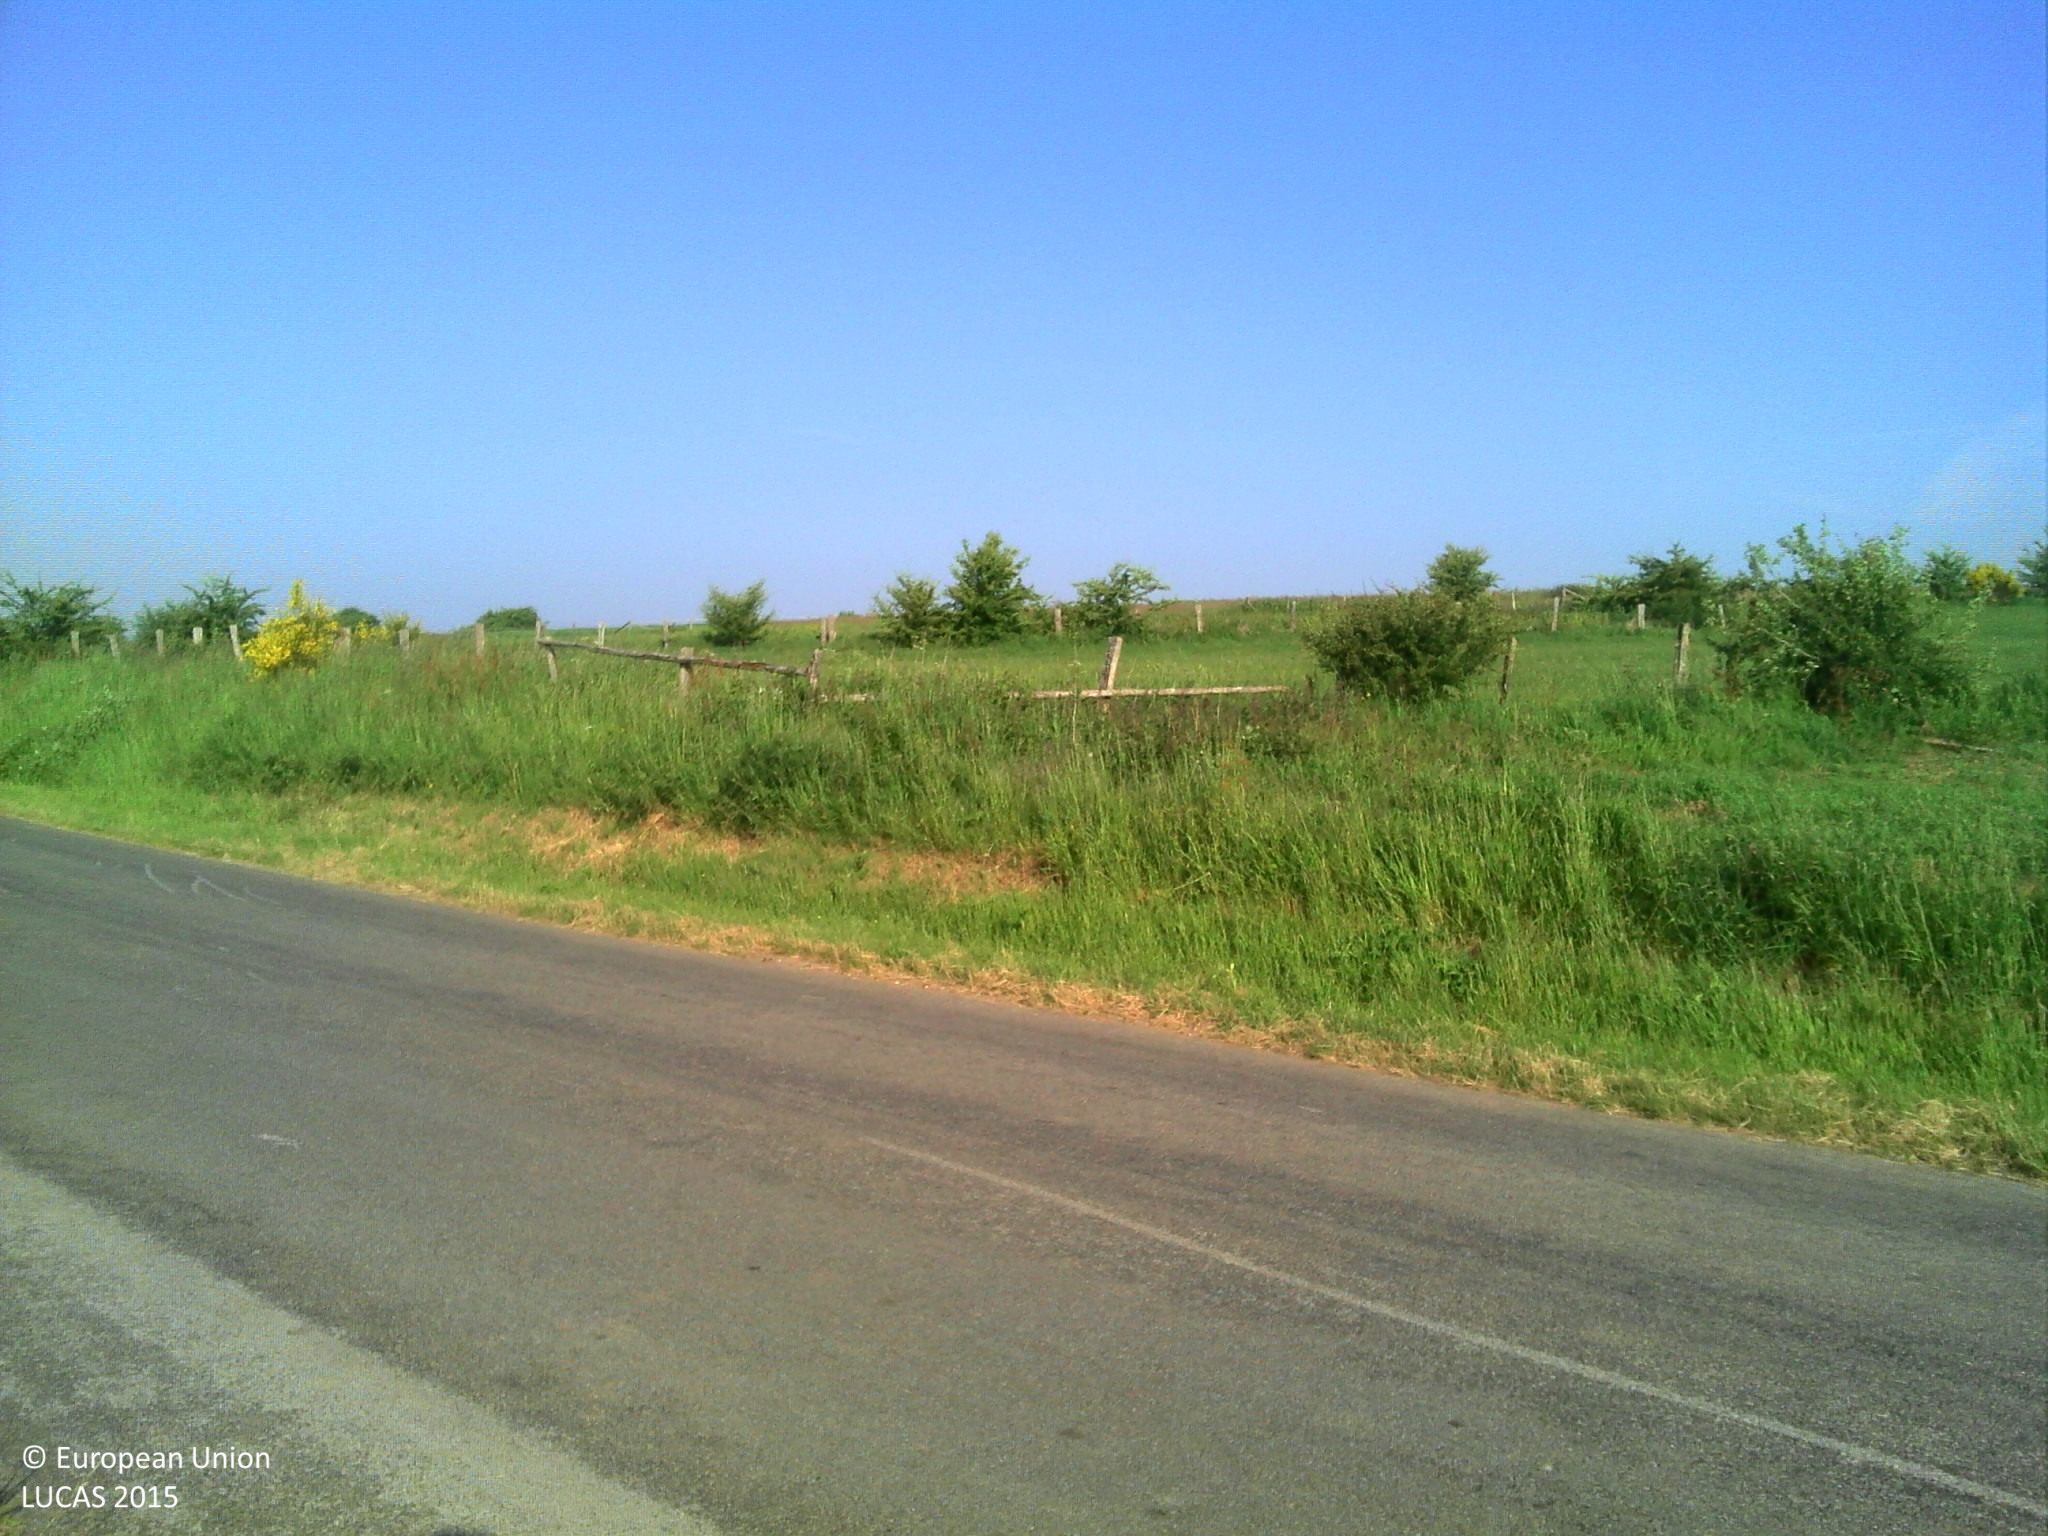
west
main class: Grassland
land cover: Grassland without tree/shrub cover
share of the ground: > 75 %
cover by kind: herbaceous plants 100 %
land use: Agriculture (excluding fallow land and kitchen gardens)
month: June
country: BE
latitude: 49.9028
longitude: 5.1943
